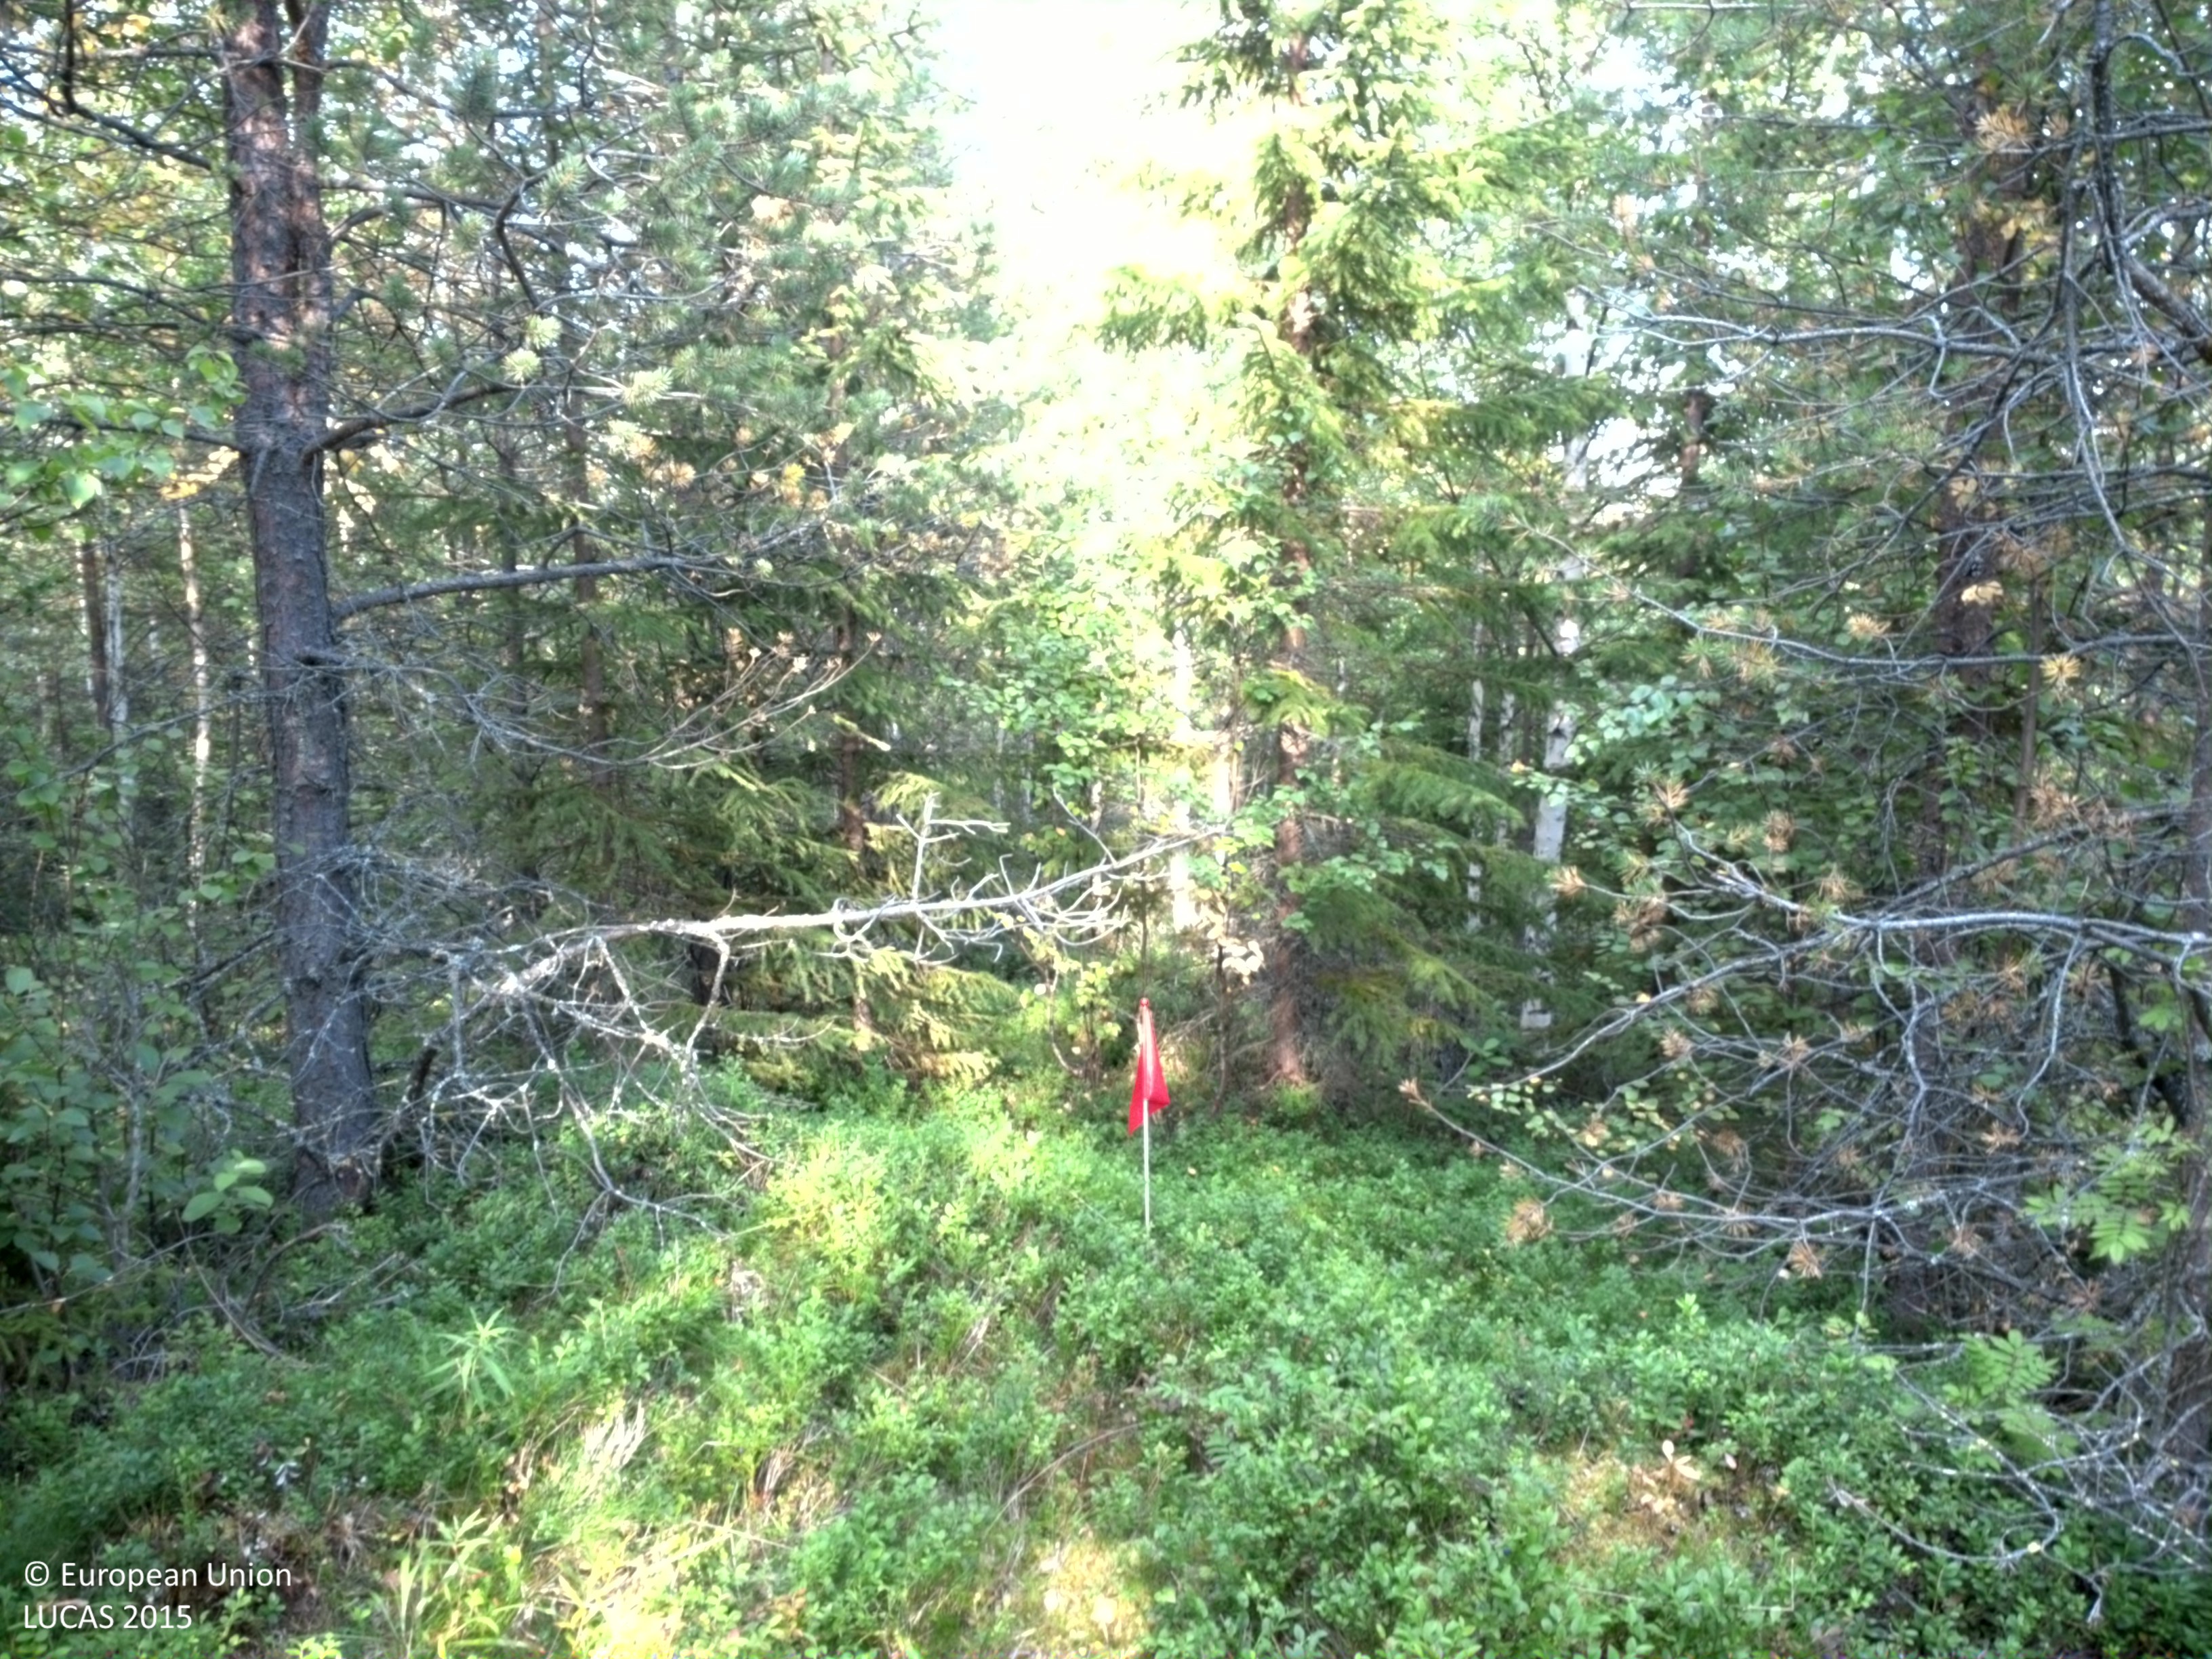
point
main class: Woodland
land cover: Pine dominated mixed woodland
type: boreal forest
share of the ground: 50 - 75 %
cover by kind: coniferous forest trees 45 %, shrubs 40 %, broadleaved forest trees 15 %
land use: Forestry
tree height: > 5 m
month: August
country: SE
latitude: 64.4401
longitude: 18.8815
